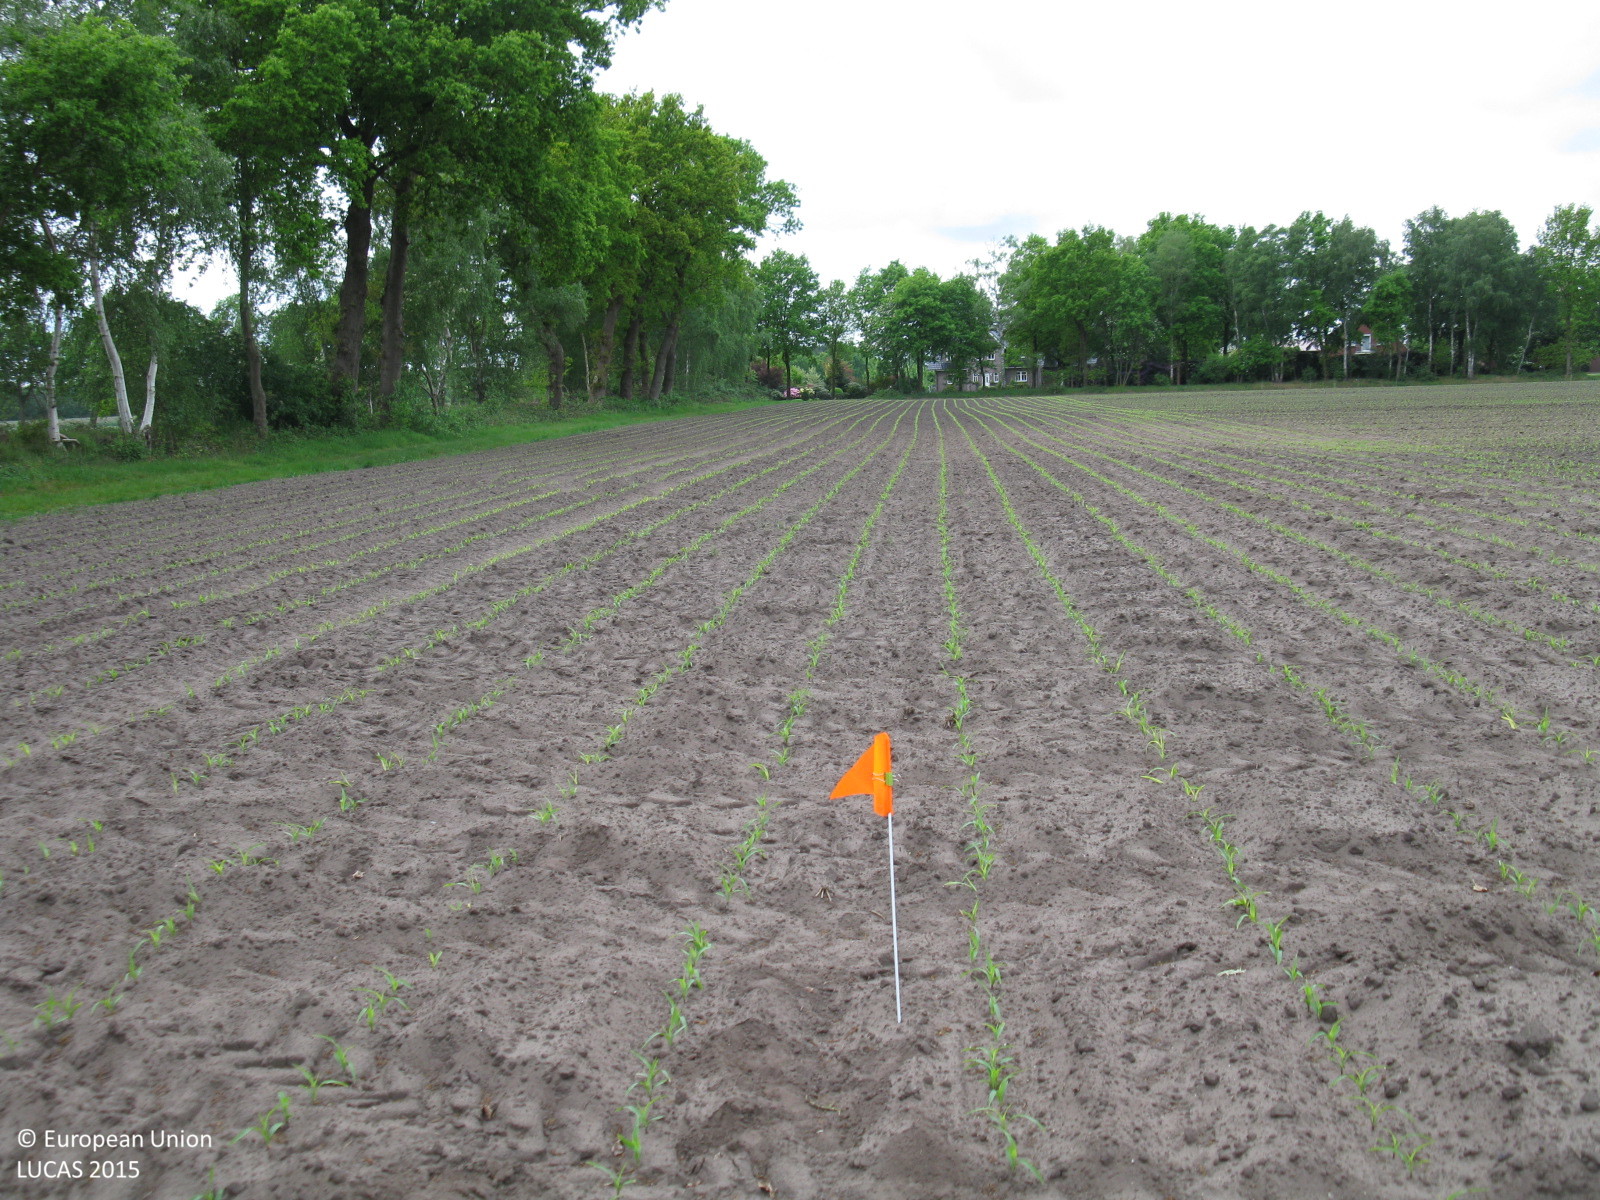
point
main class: Cropland
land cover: Maize
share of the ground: < 10 %
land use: Agriculture (excluding fallow land and kitchen gardens)
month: May
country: DE
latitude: 52.9708
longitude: 7.9308
